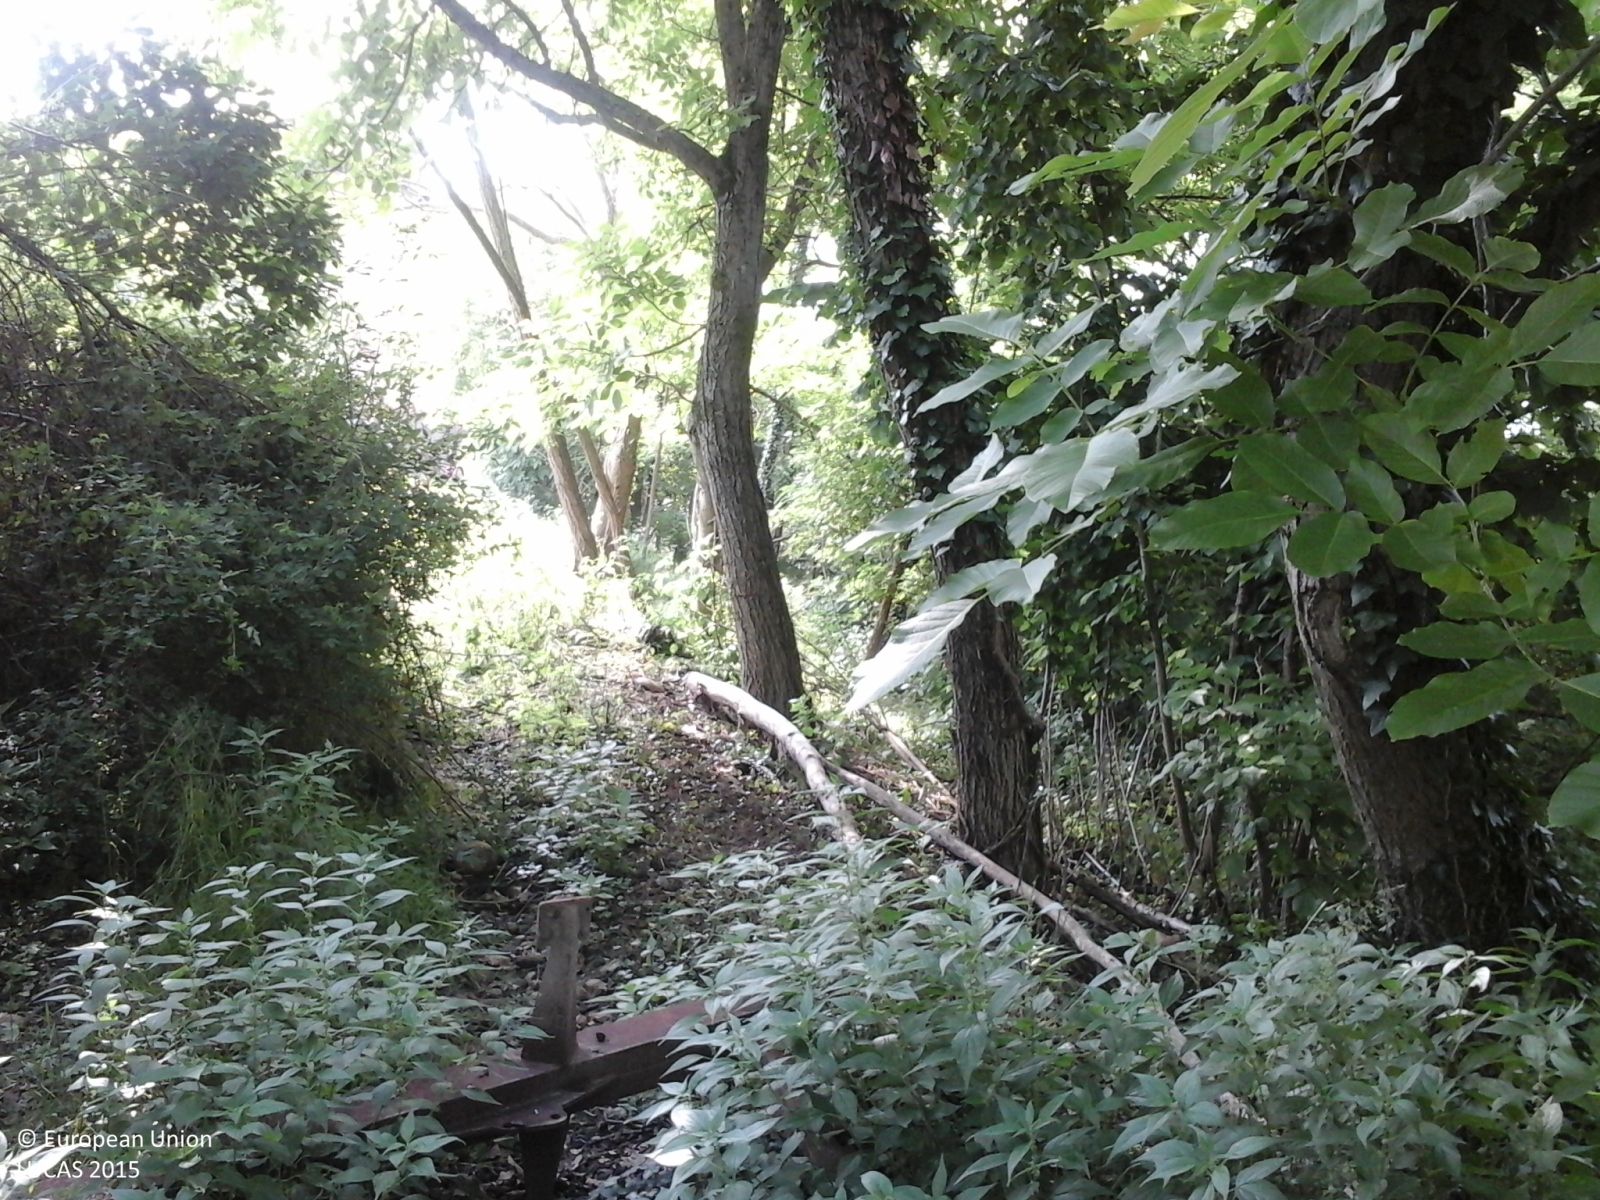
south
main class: Woodland
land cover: Broadleaved woodland
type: thermophilous deciduous forest
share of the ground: > 75 %
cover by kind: broadleaved forest trees 80 %, shrubs 10 %, herbaceous plants 10 %
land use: Forestry
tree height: > 5 m
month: May
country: IT
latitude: 44.6344
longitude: 7.8235
